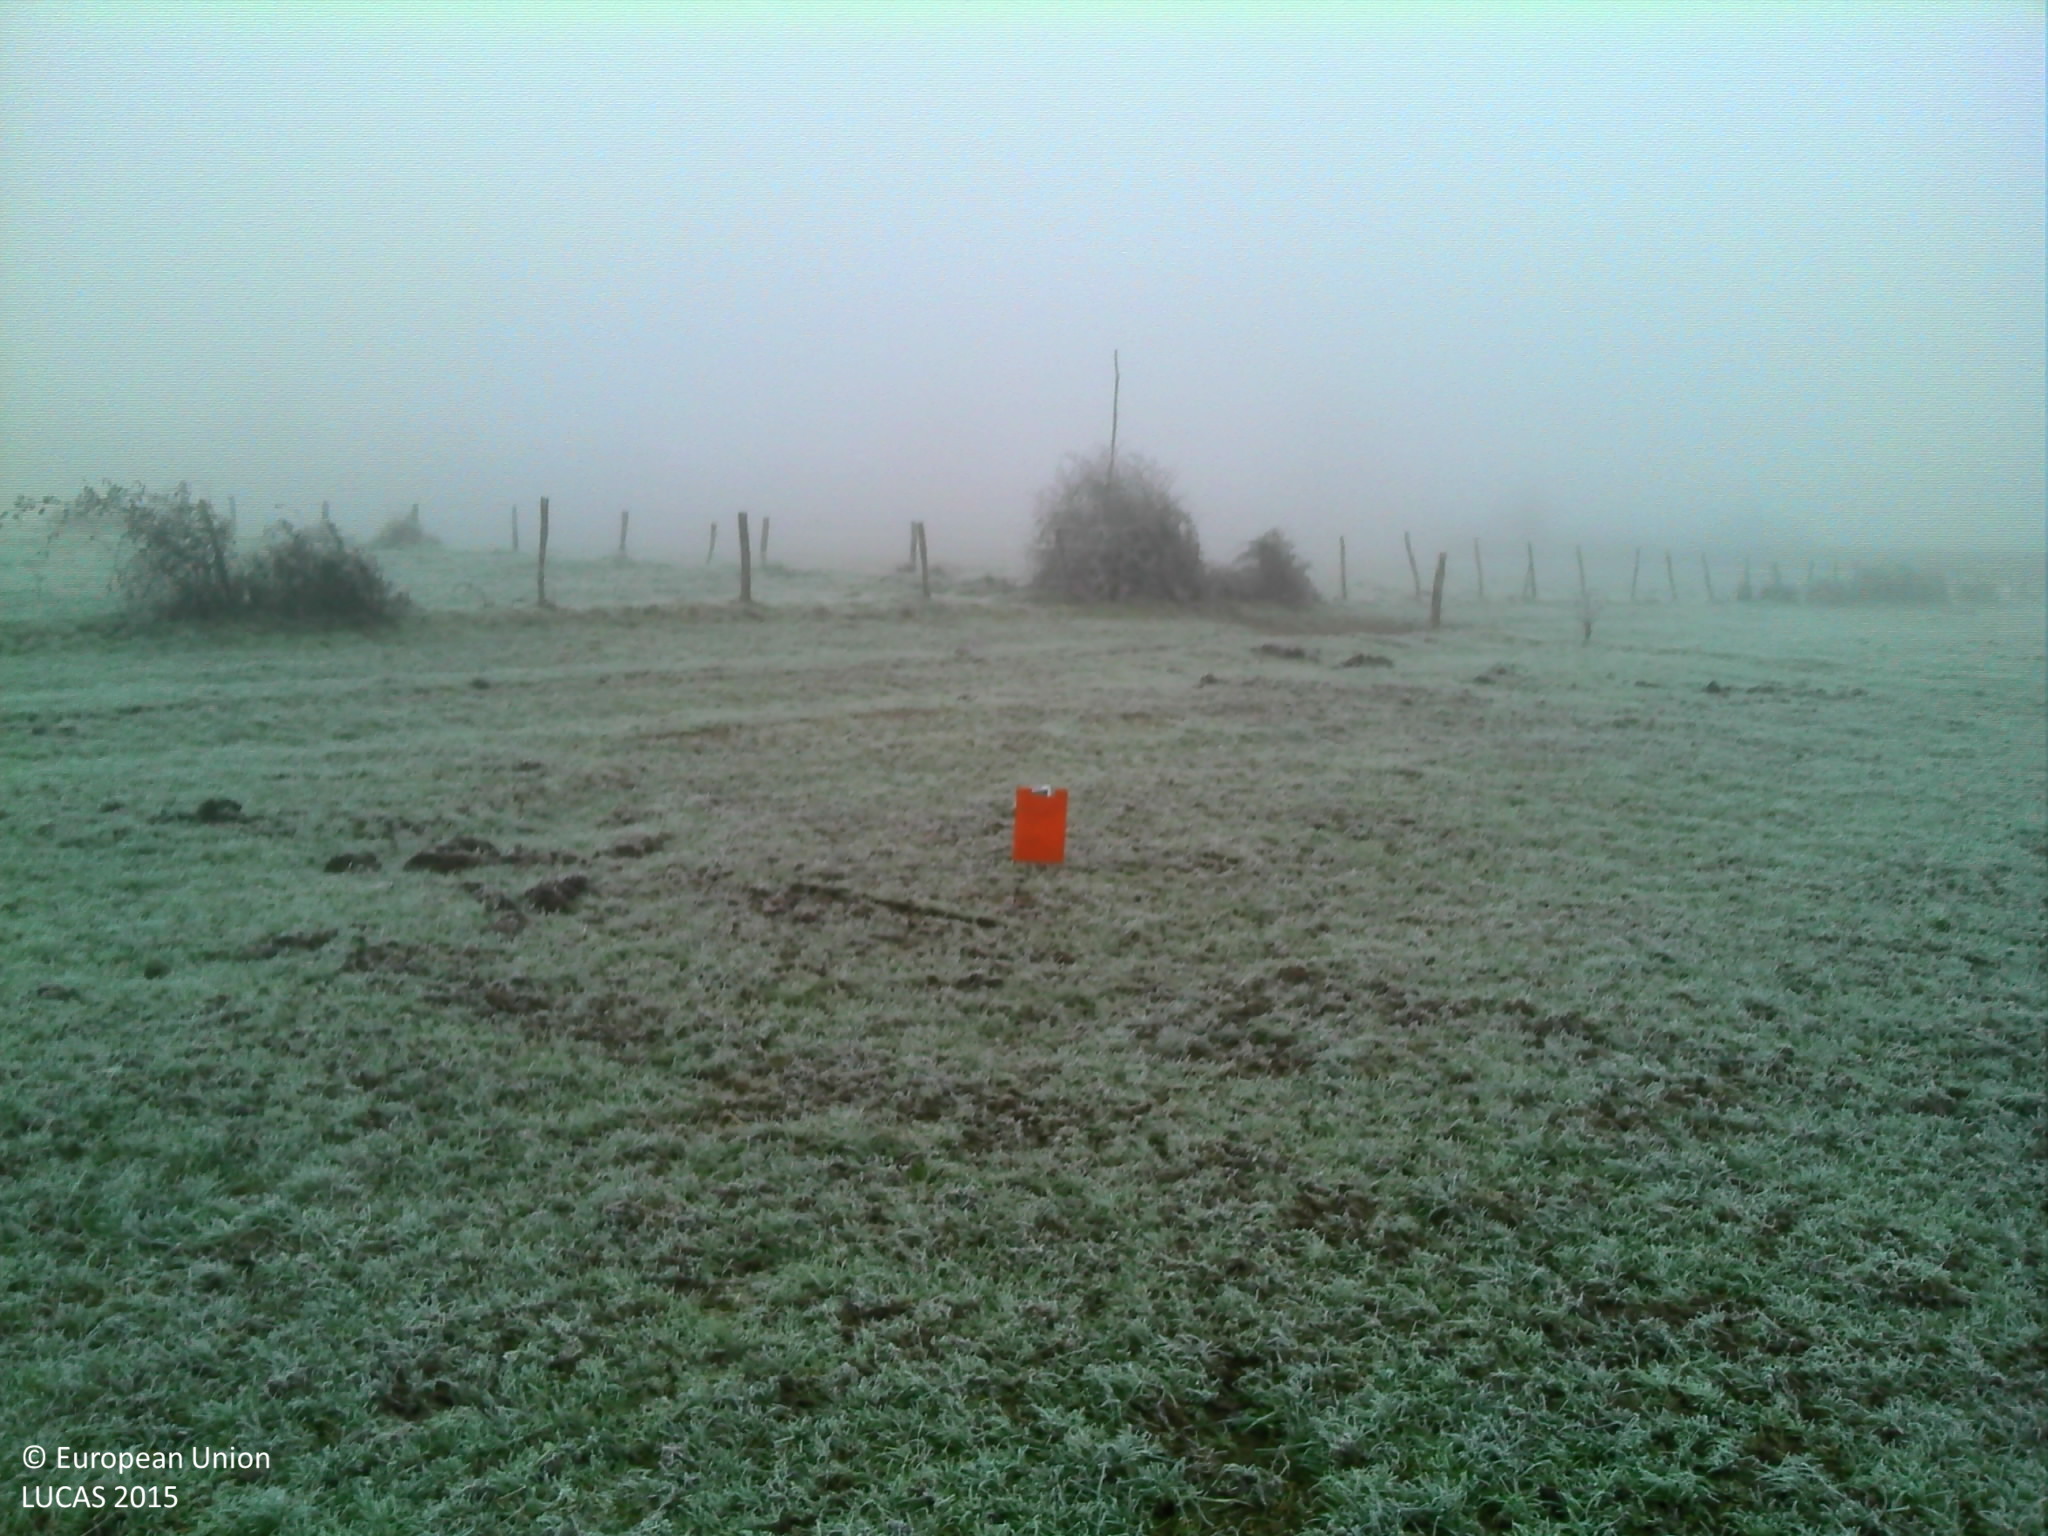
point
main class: Grassland
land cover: Grassland without tree/shrub cover
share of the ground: > 75 %
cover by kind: herbaceous plants 100 %
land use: Agriculture (excluding fallow land and kitchen gardens)
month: November
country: FR
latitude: 46.5925
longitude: 3.5902
